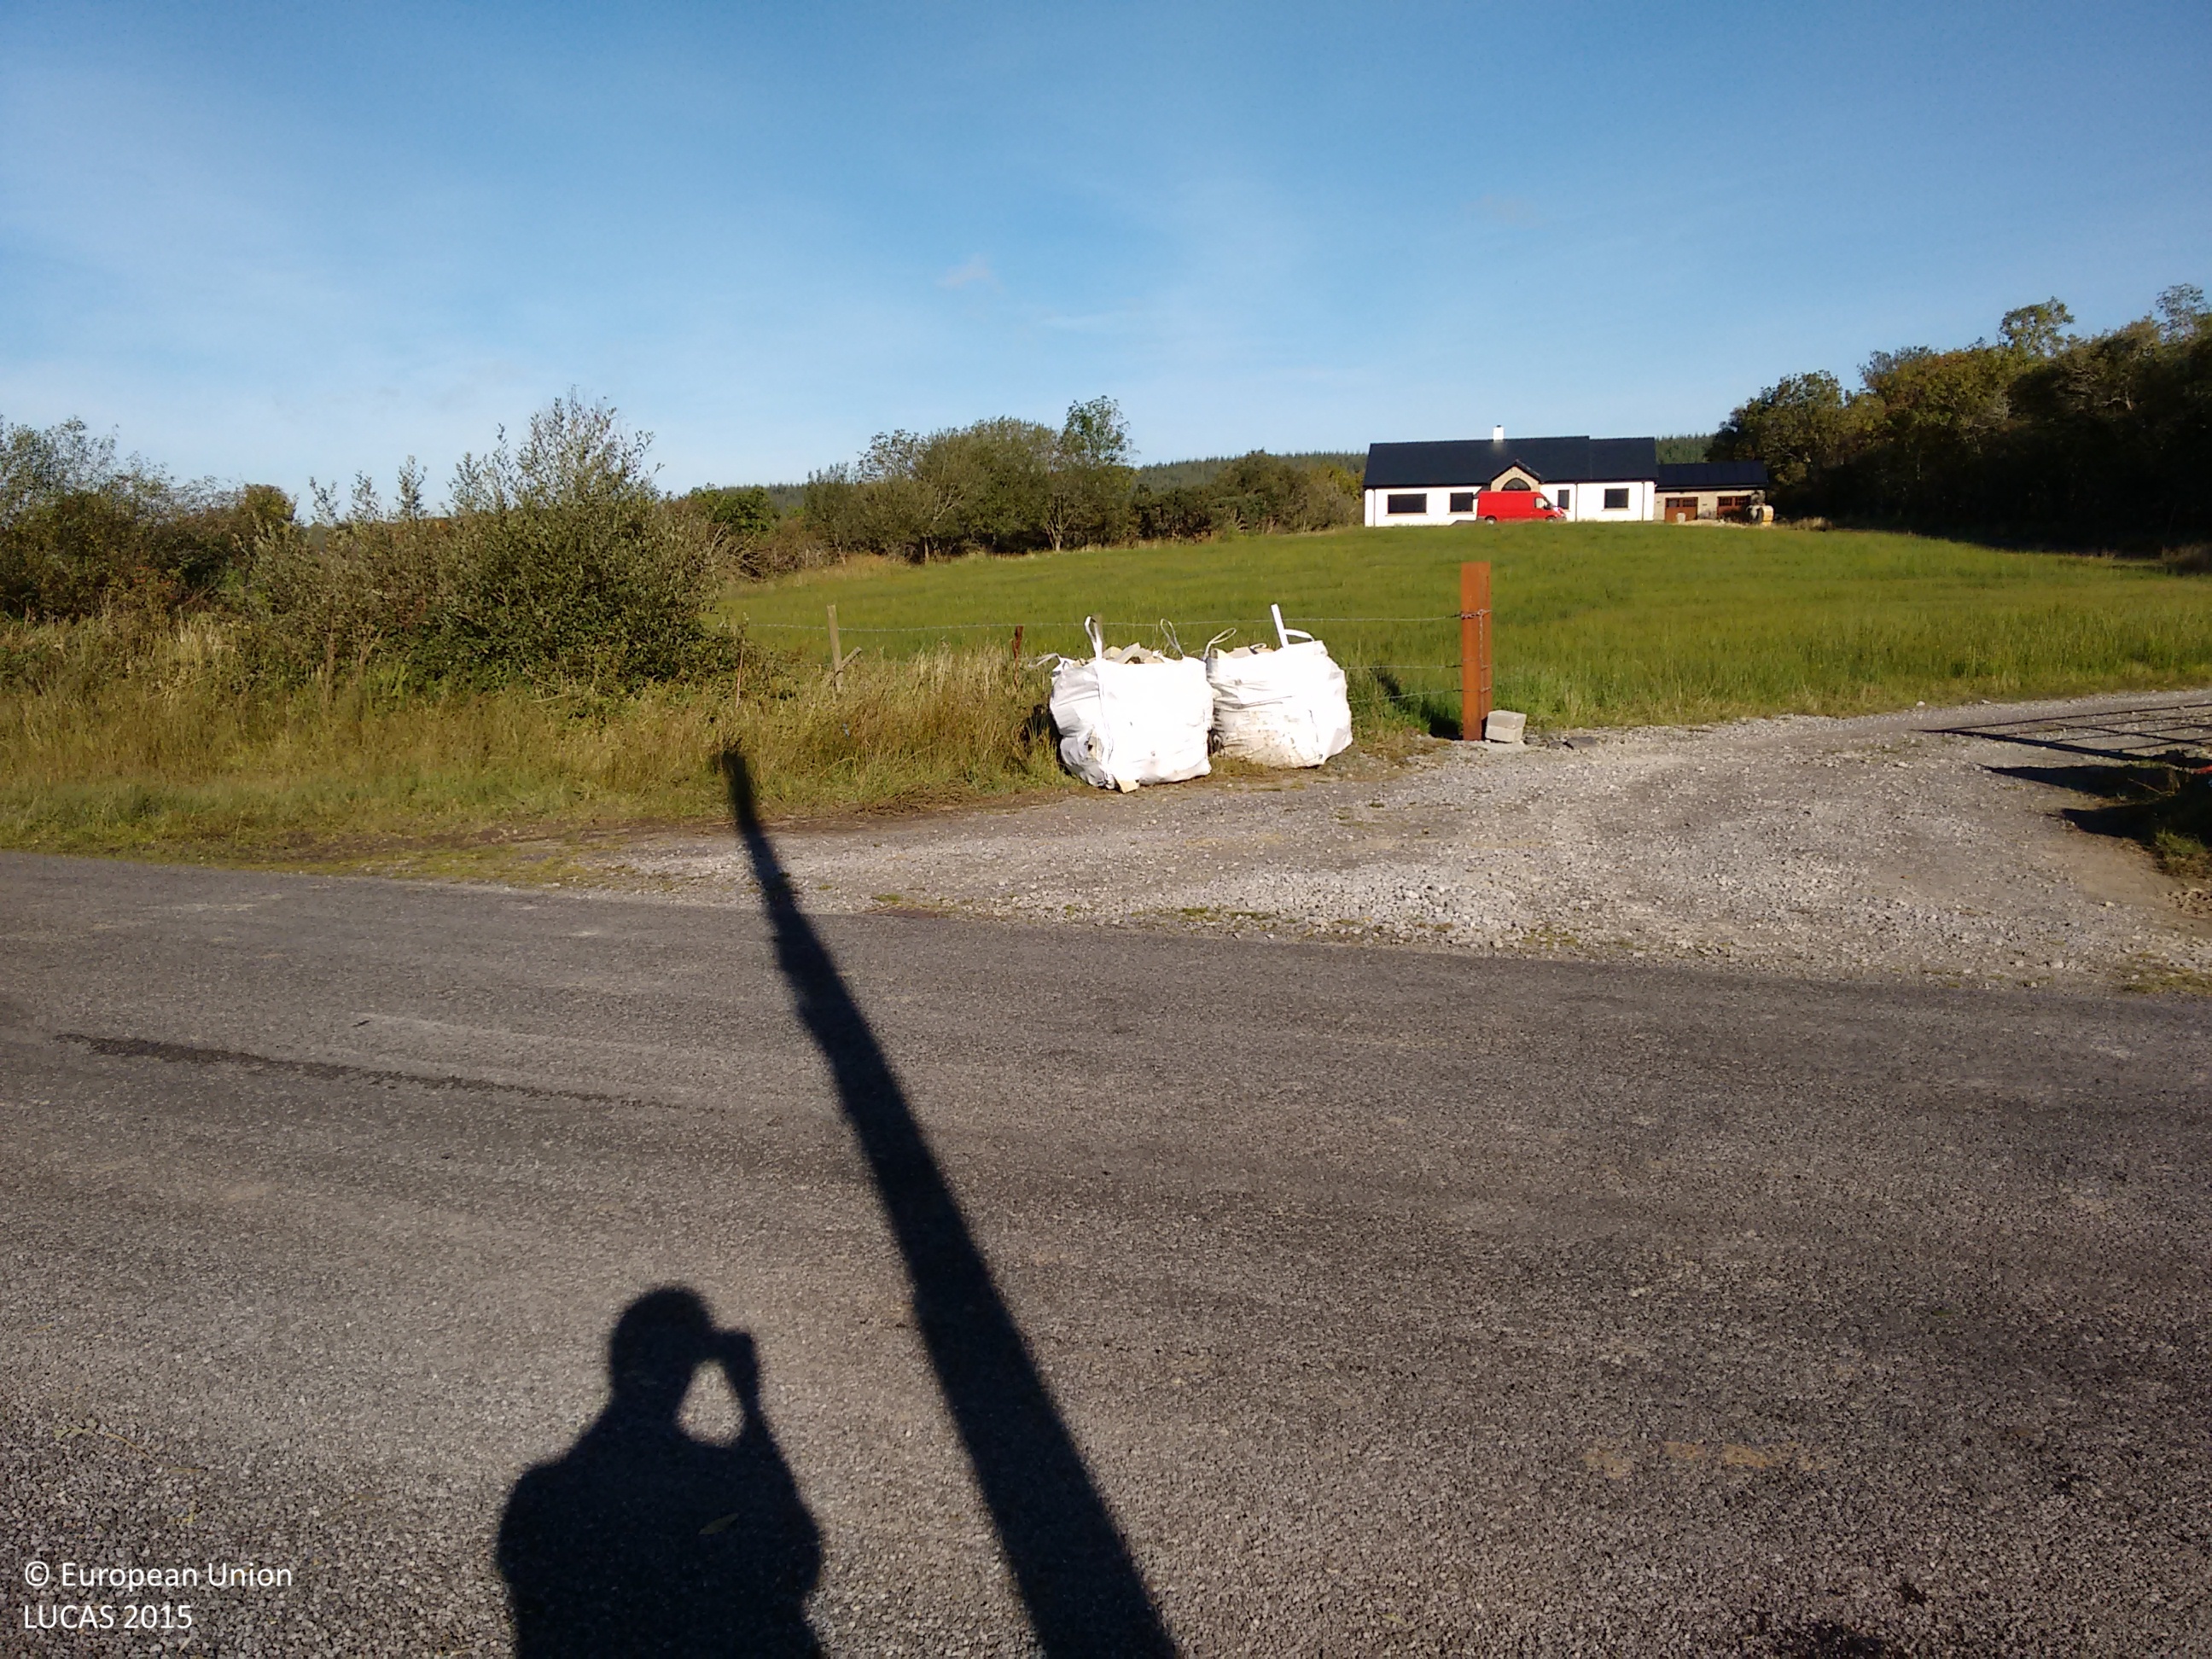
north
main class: Grassland
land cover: Grassland without tree/shrub cover
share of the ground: > 75 %
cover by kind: herbaceous plants 100 %
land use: Agriculture (excluding fallow land and kitchen gardens)
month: October
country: GB
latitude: 54.4341
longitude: -8.1384
